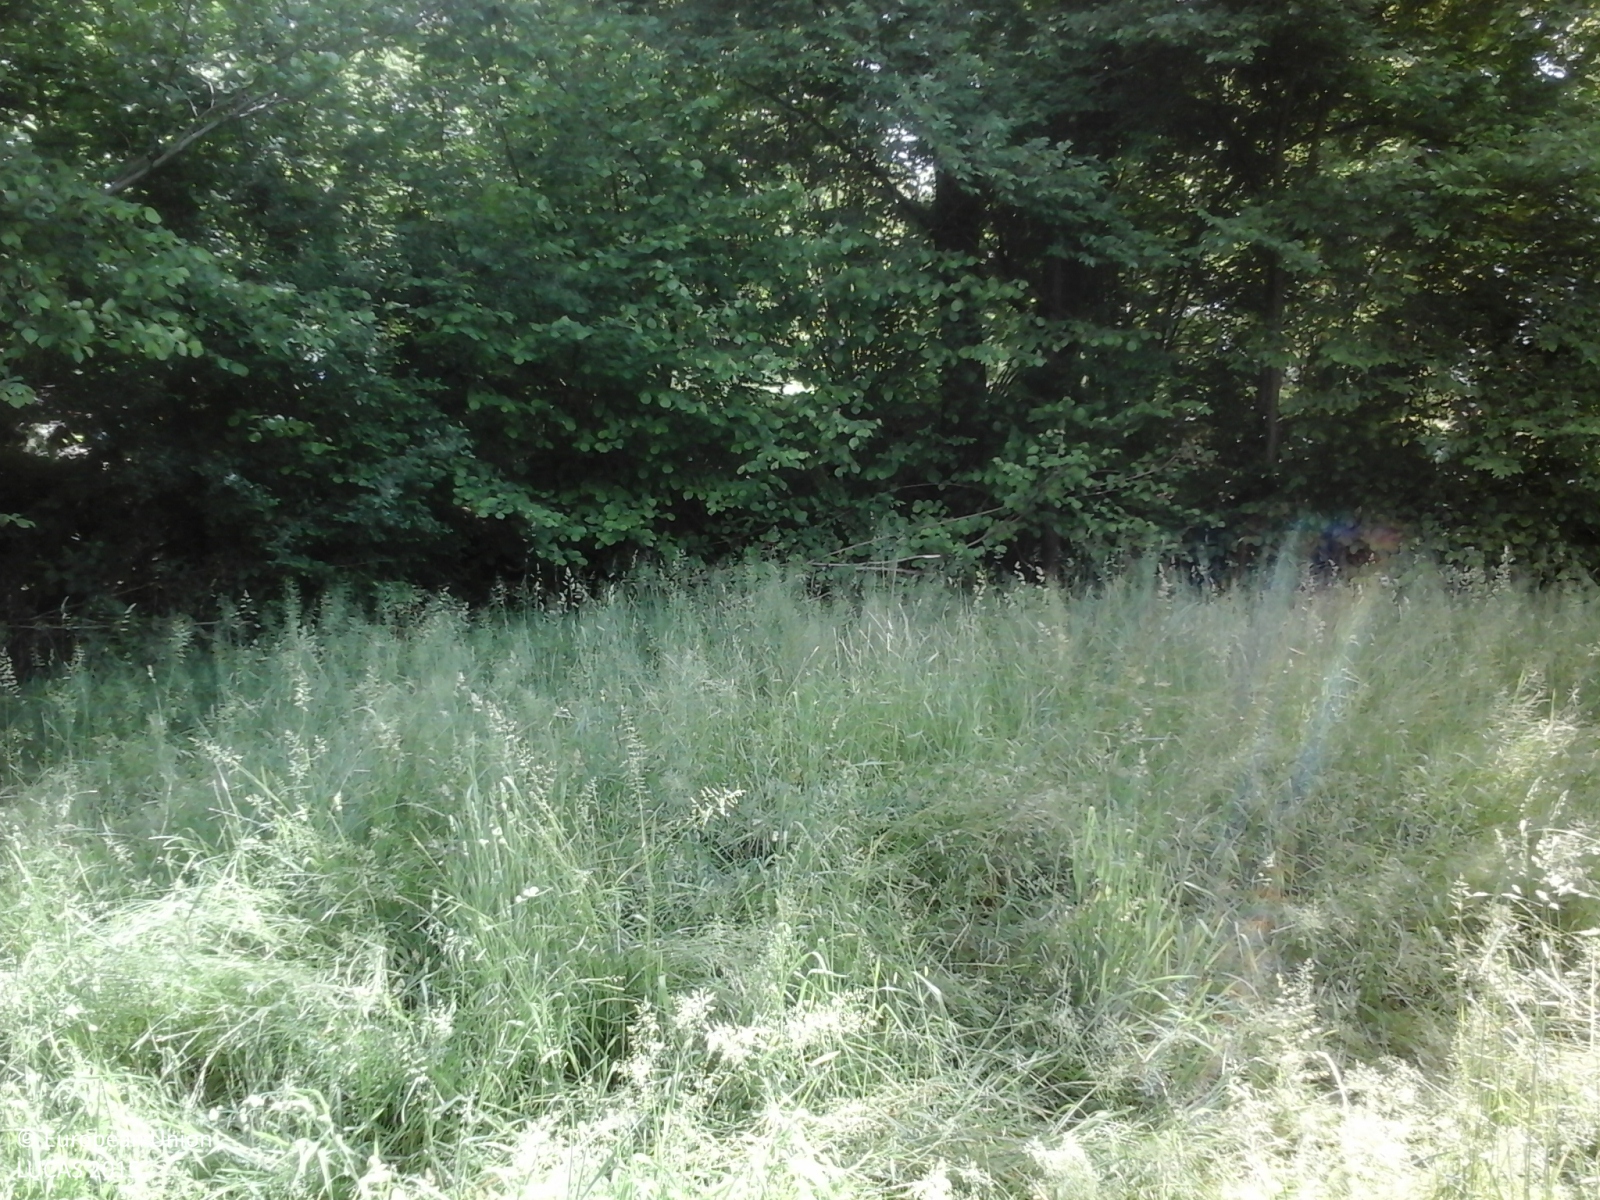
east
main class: Grassland
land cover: Grassland with sparse tree/shrub cover
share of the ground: > 75 %
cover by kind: herbaceous plants 95 %, broadleaved forest trees 5 %
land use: Agriculture (excluding fallow land and kitchen gardens)
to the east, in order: Grassland with sparse tree/shrub cover; Ditches and canals; Broadleaved woodland; Tracks; Broadleaved woodland; Tracks; Broadleaved woodland; Fences; Grassland without tree/shrub cover; Broadleaved woodland; Grassland without tree/shrub cover
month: May
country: IT
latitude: 45.7114
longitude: 8.6020
